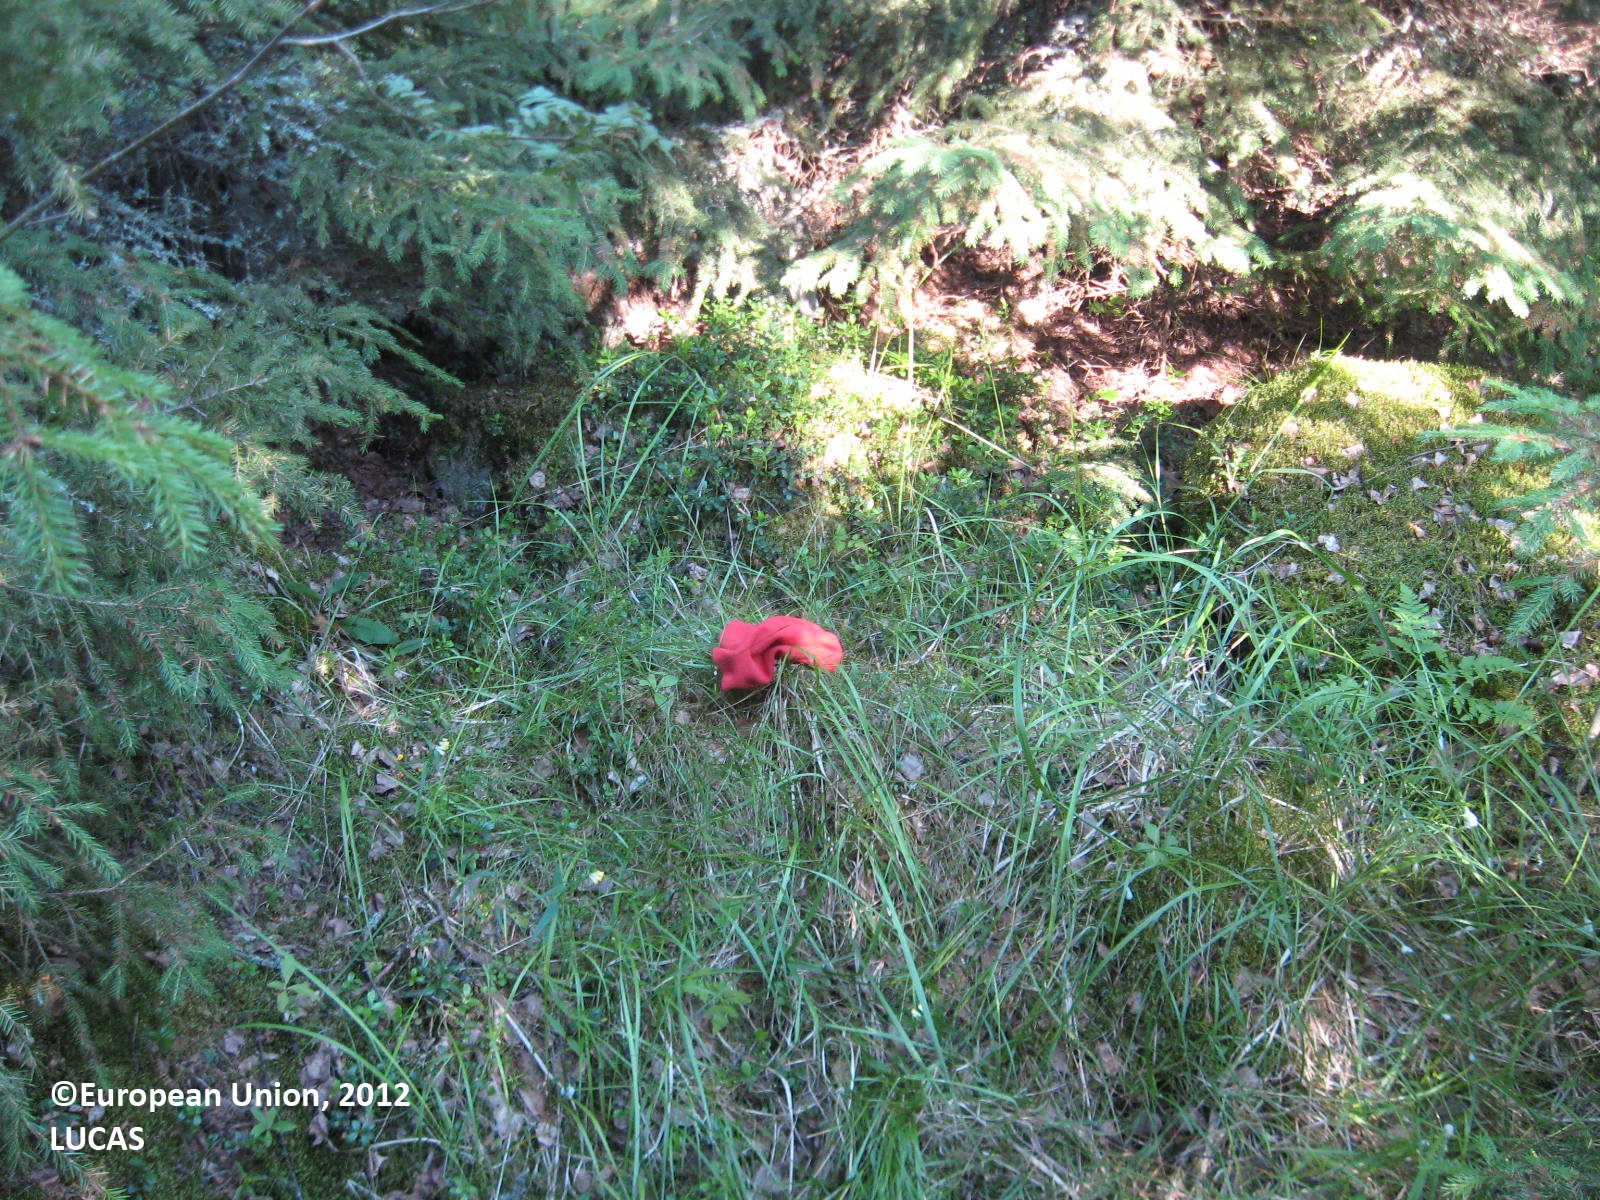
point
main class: Woodland
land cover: Spruce dominated coniferous woodland
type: boreal forest
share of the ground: > 75 %
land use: Forestry
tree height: > 5 m
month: July
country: FI
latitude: 62.1696
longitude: 21.5086
